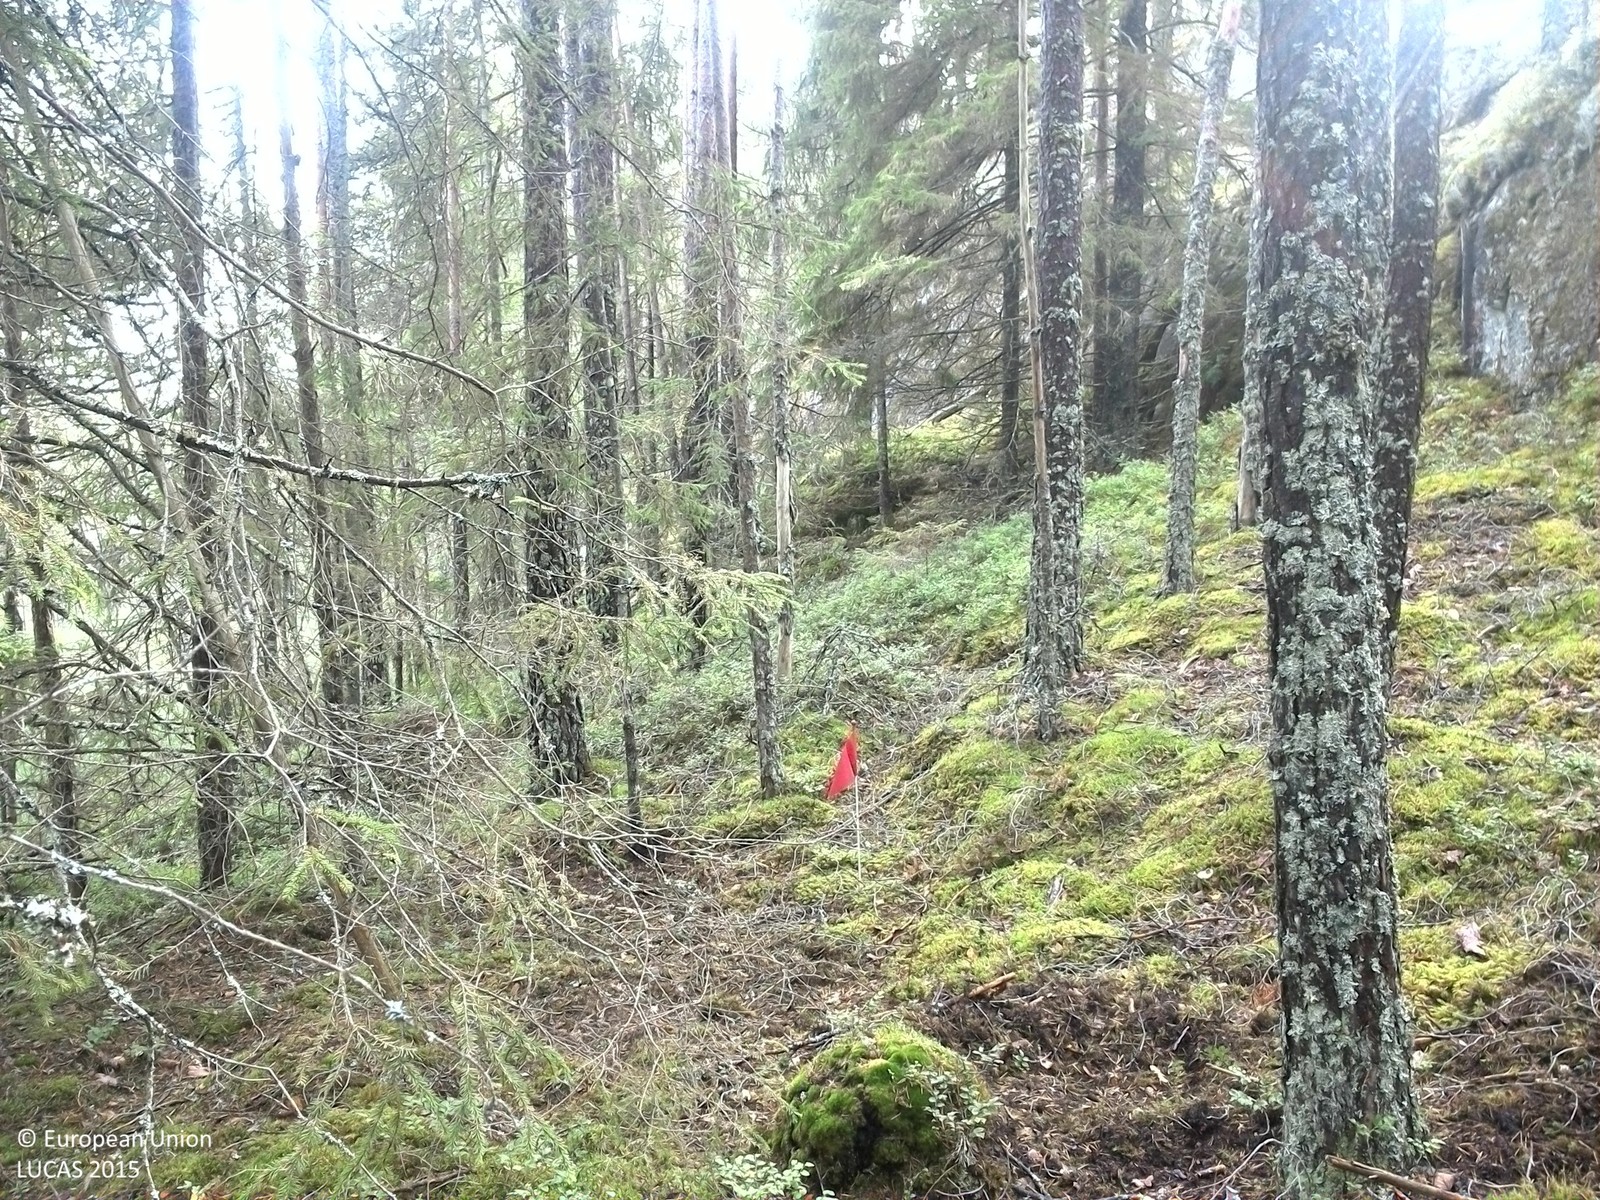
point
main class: Woodland
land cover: Pine dominated coniferous woodland
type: boreal forest
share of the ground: 50 - 75 %
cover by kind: coniferous forest trees 65 %, shrubs 20 %, lichens and mosses 10 %, broadleaved forest trees 5 %
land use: Forestry
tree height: > 5 m
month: September
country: SE
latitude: 59.3021
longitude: 12.0145
